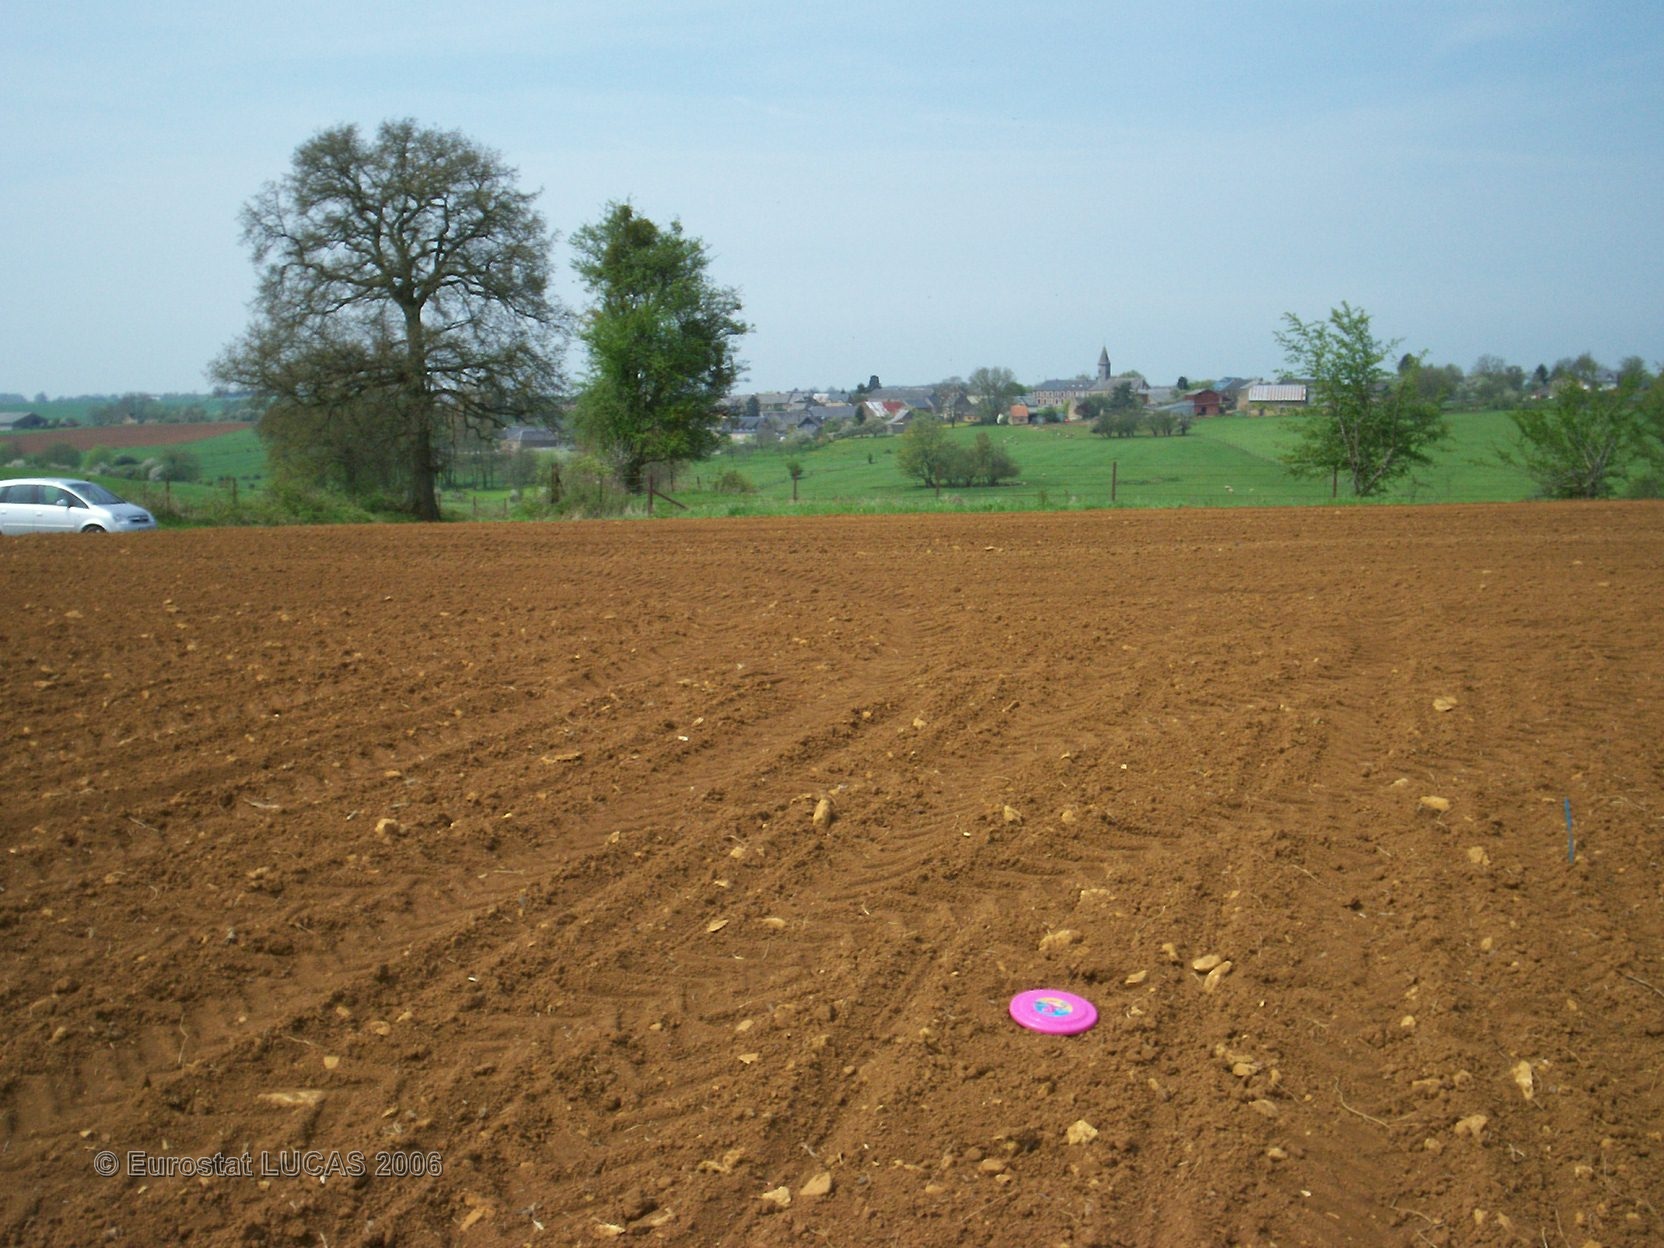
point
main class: Cropland
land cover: Maize
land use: Agriculture (excluding fallow land and kitchen gardens)
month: May
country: FR
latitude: 49.8631
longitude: 4.3336
